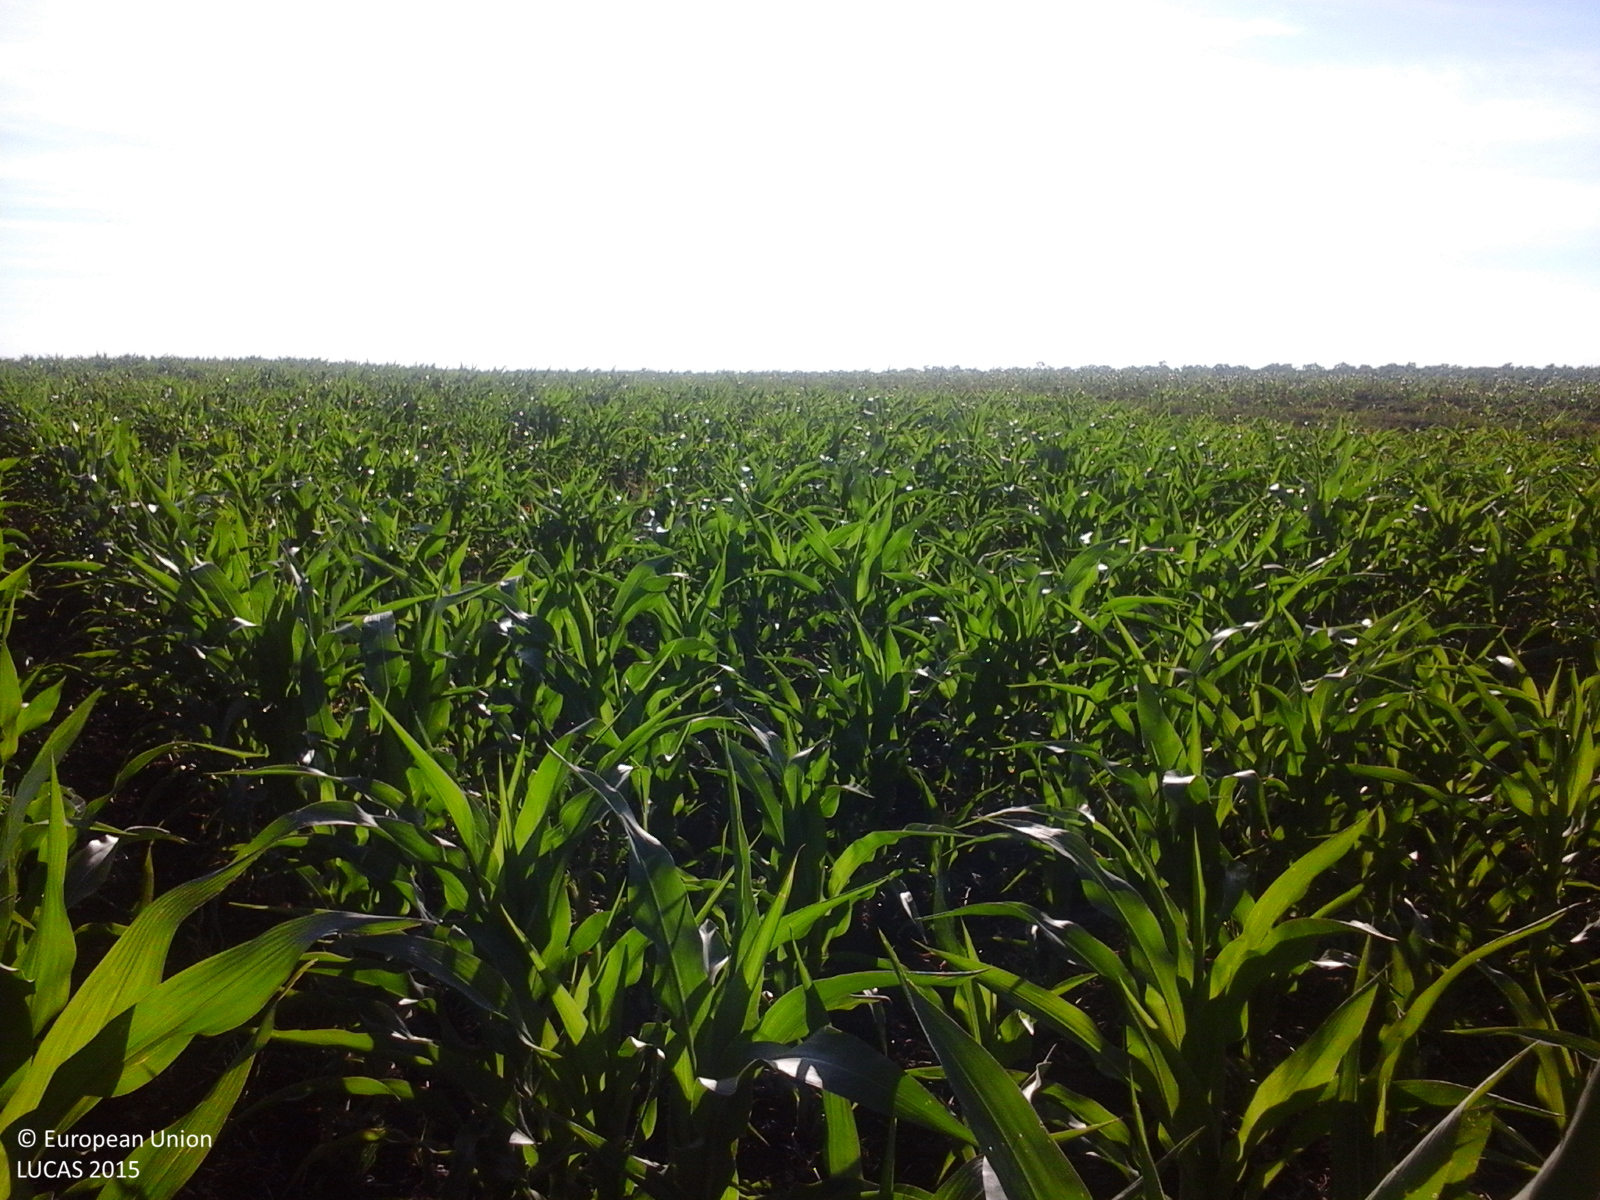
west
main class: Cropland
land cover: Maize
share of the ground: 50 - 75 %
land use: Agriculture (excluding fallow land and kitchen gardens)
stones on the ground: < 10 %
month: June
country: RO
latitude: 47.3199
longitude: 27.1875
